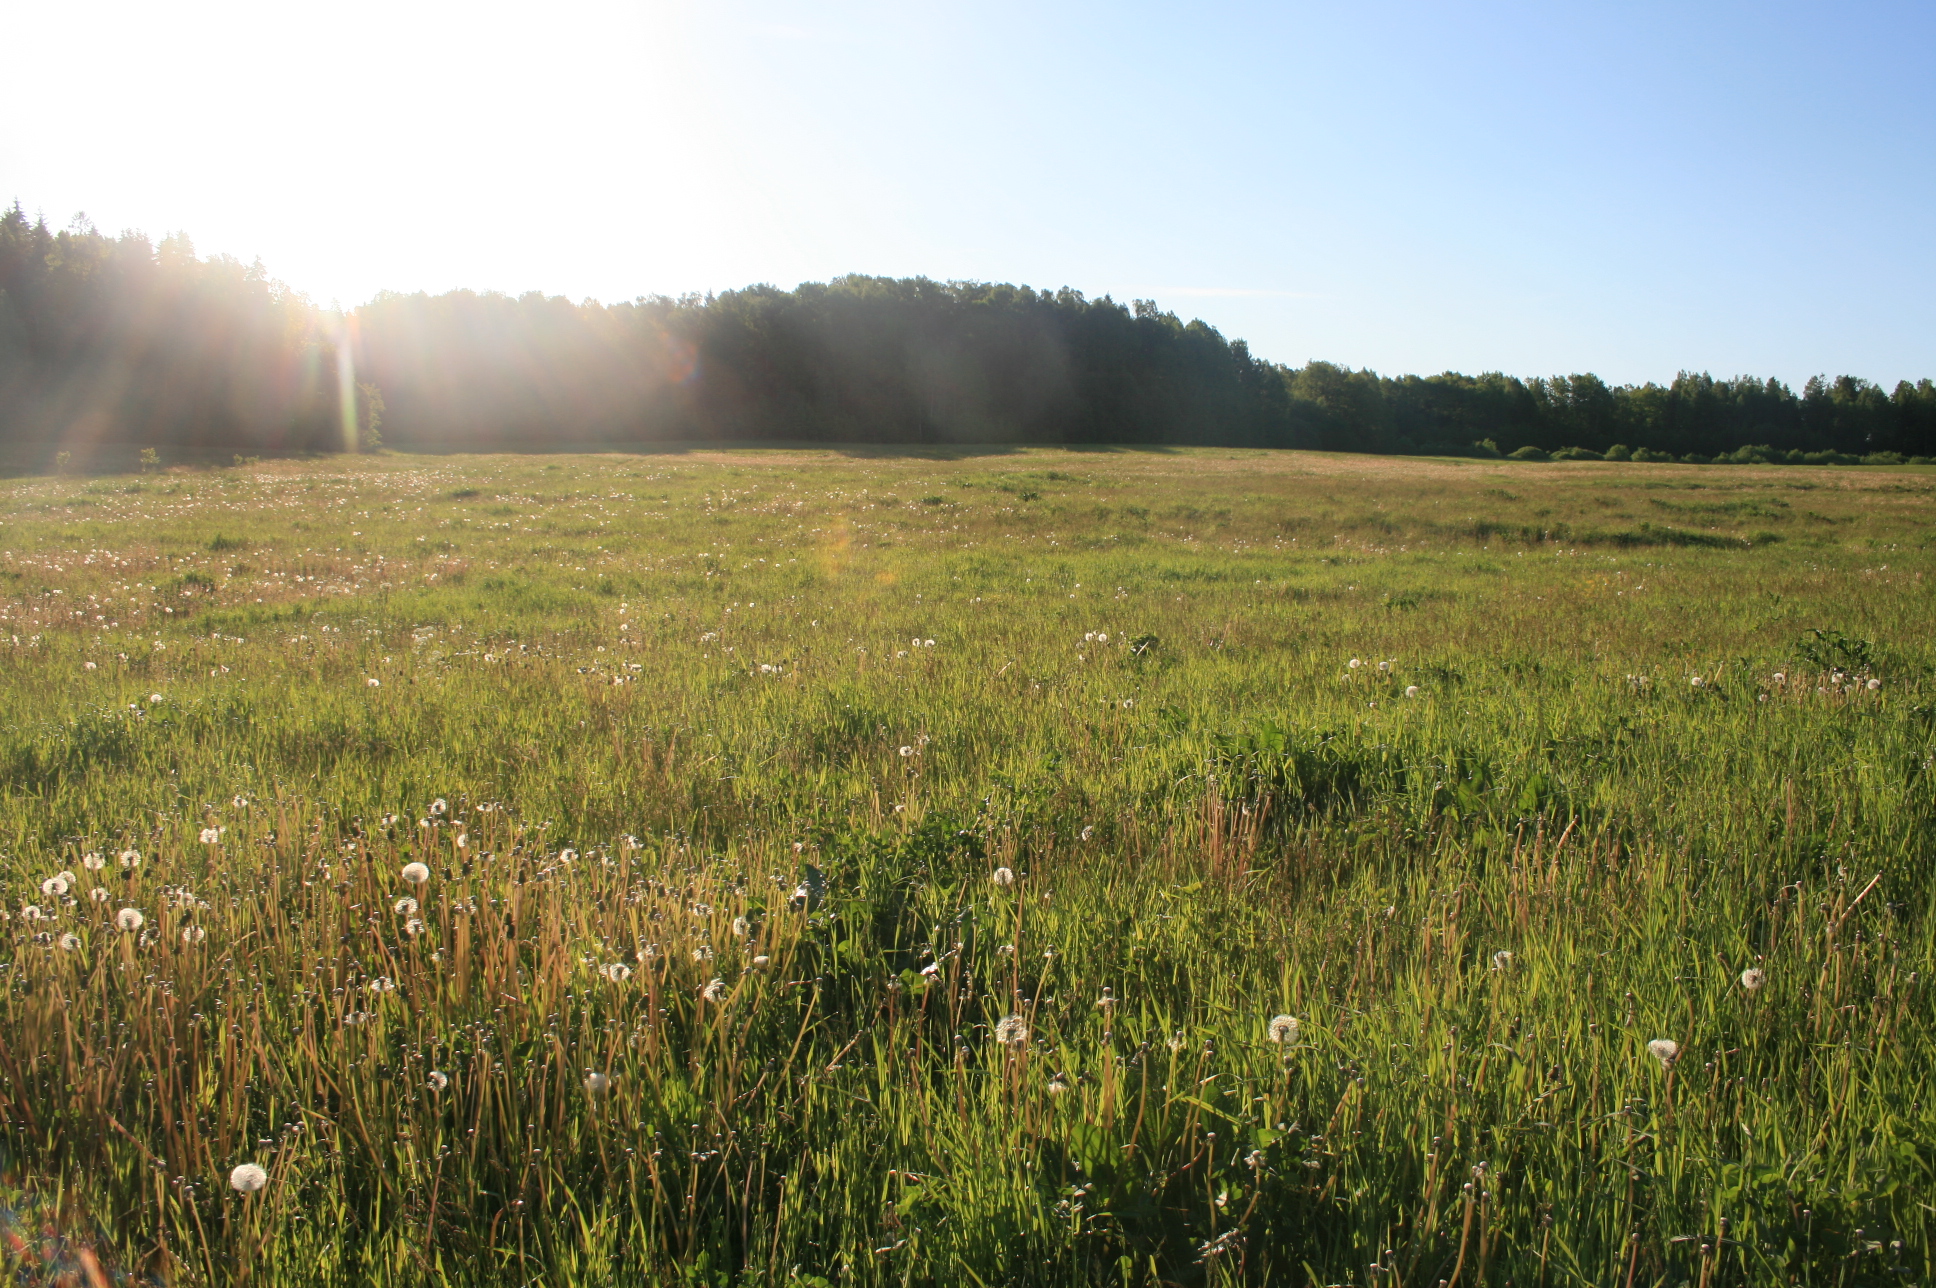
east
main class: Grassland
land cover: Grassland without tree/shrub cover
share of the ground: > 75 %
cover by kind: herbaceous plants 100 %
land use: Agriculture (excluding fallow land and kitchen gardens)
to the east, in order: Grassland without tree/shrub cover; Broadleaved woodland
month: June
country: LT
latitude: 55.8984
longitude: 21.9658
